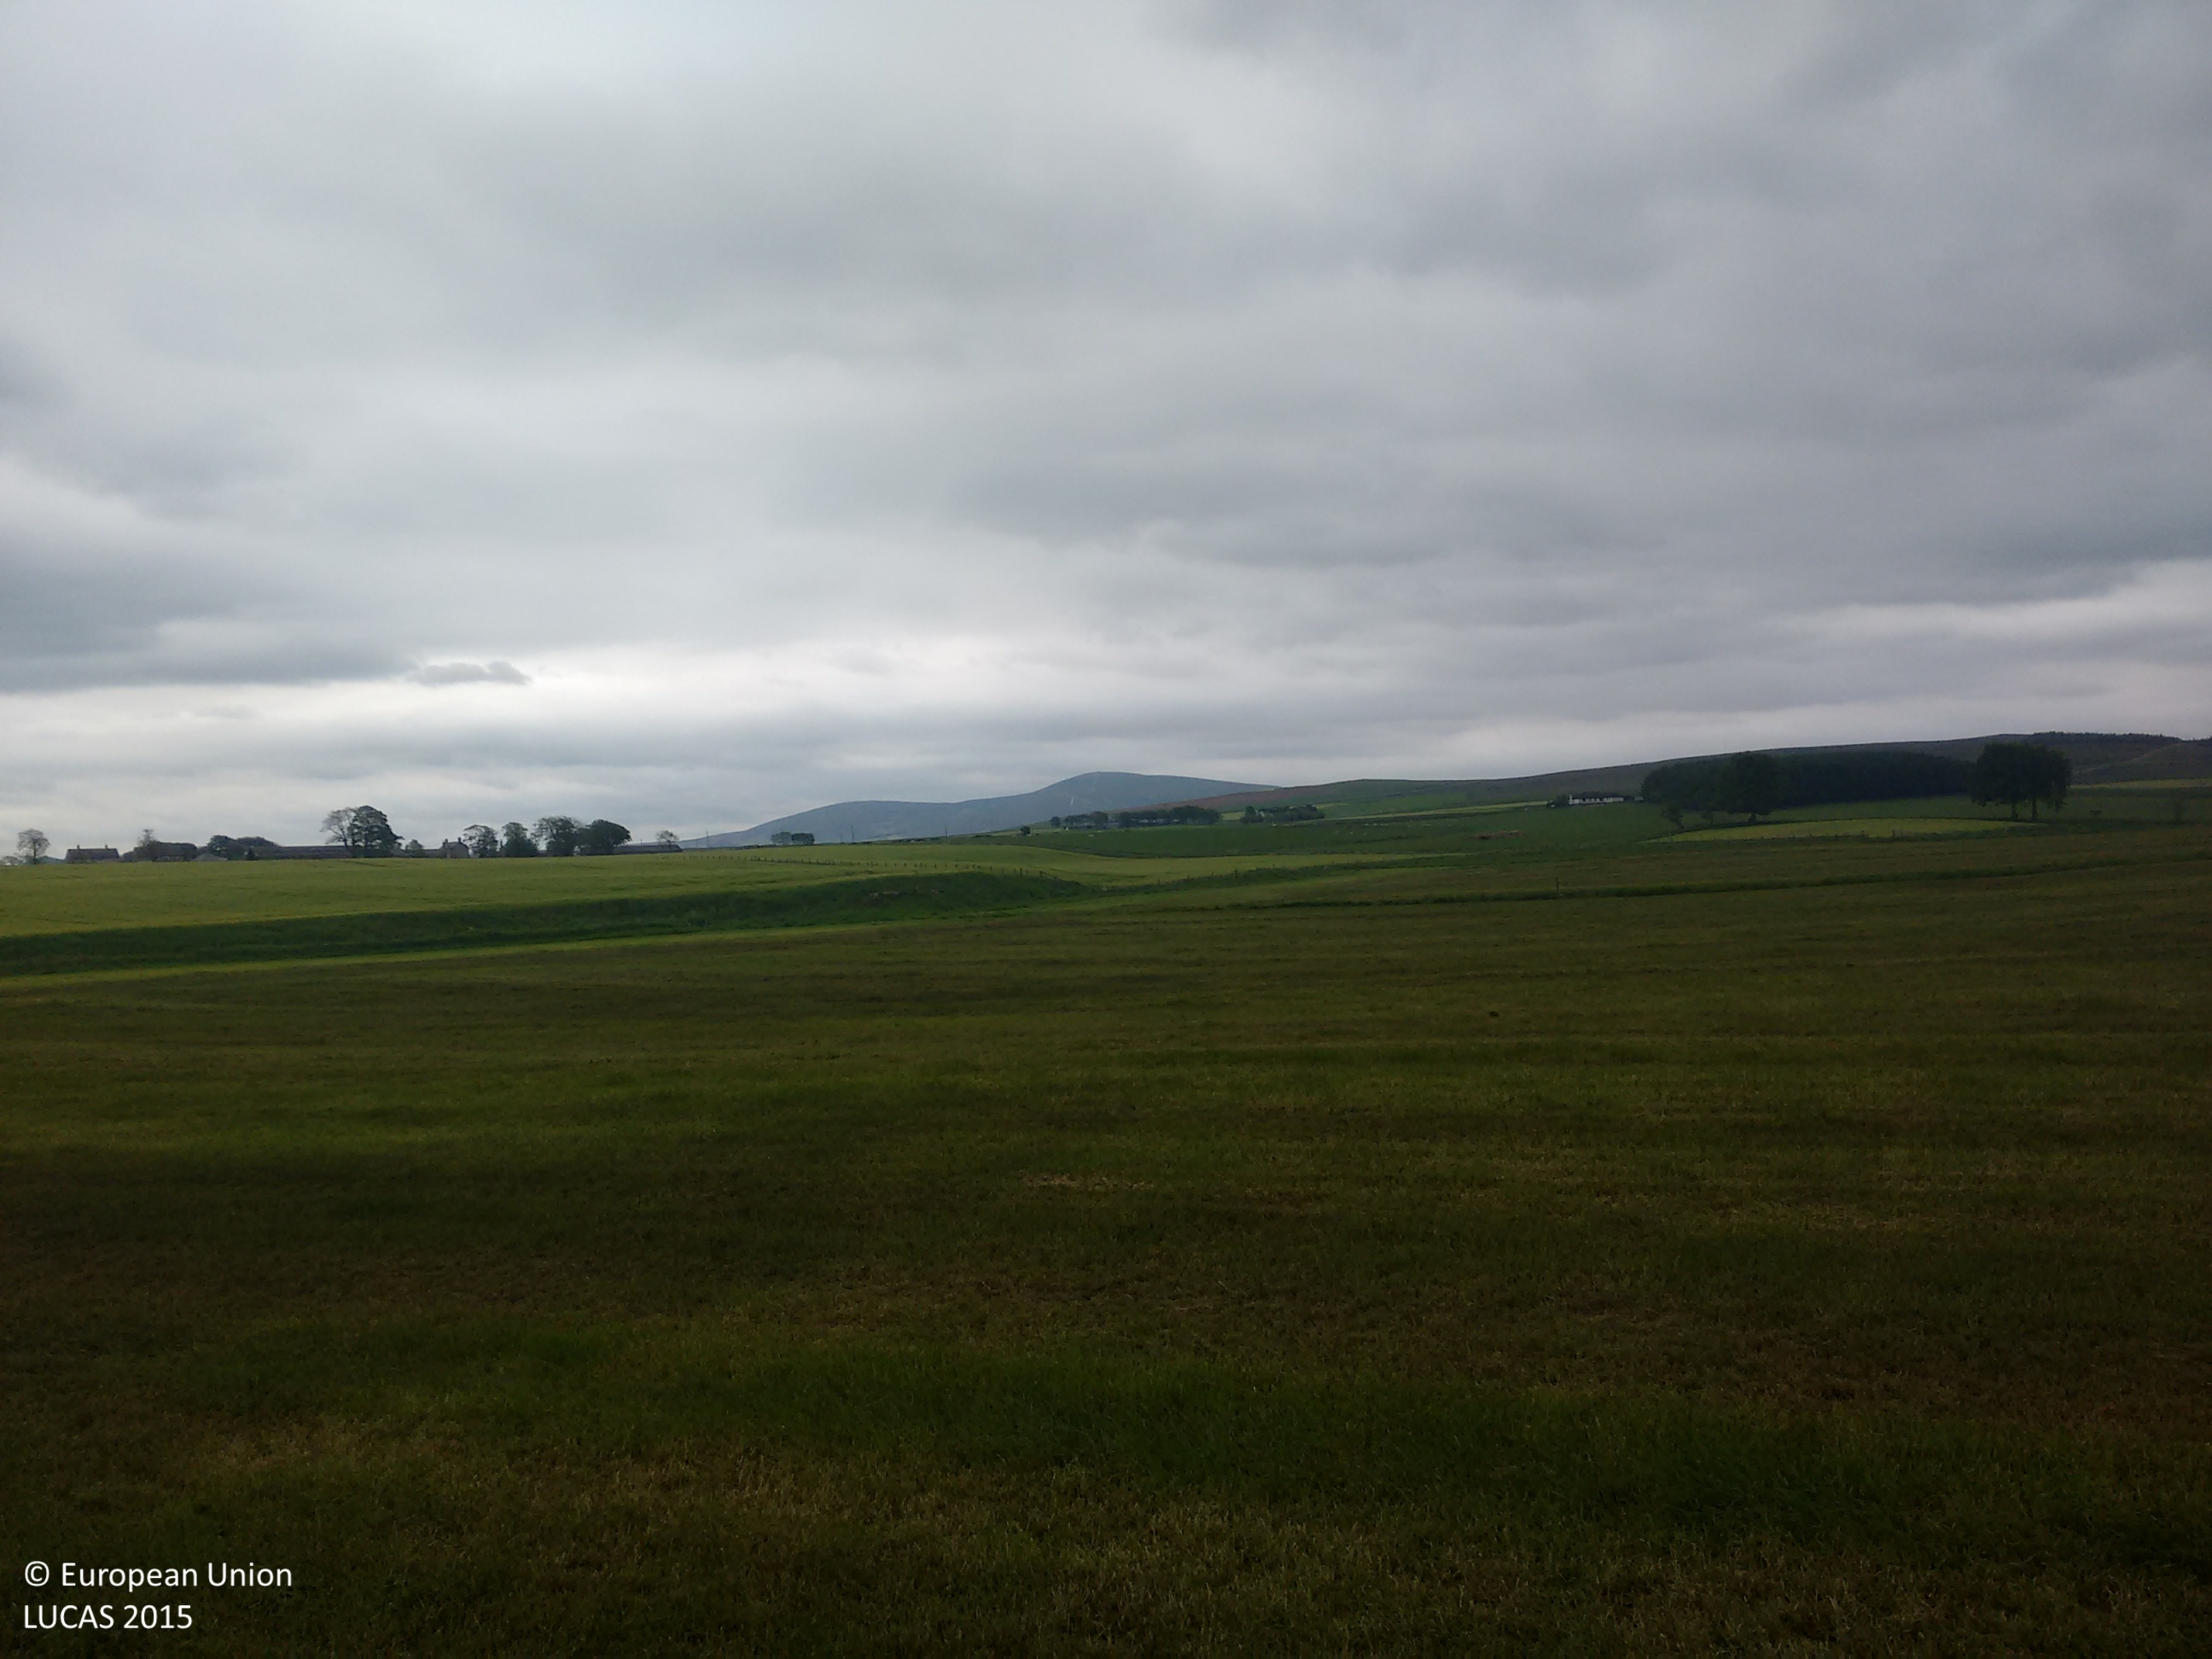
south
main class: Grassland
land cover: Grassland without tree/shrub cover
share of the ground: > 75 %
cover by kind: herbaceous plants 100 %
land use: Agriculture (excluding fallow land and kitchen gardens)
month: June
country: GB
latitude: 55.6734
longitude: -3.6446
